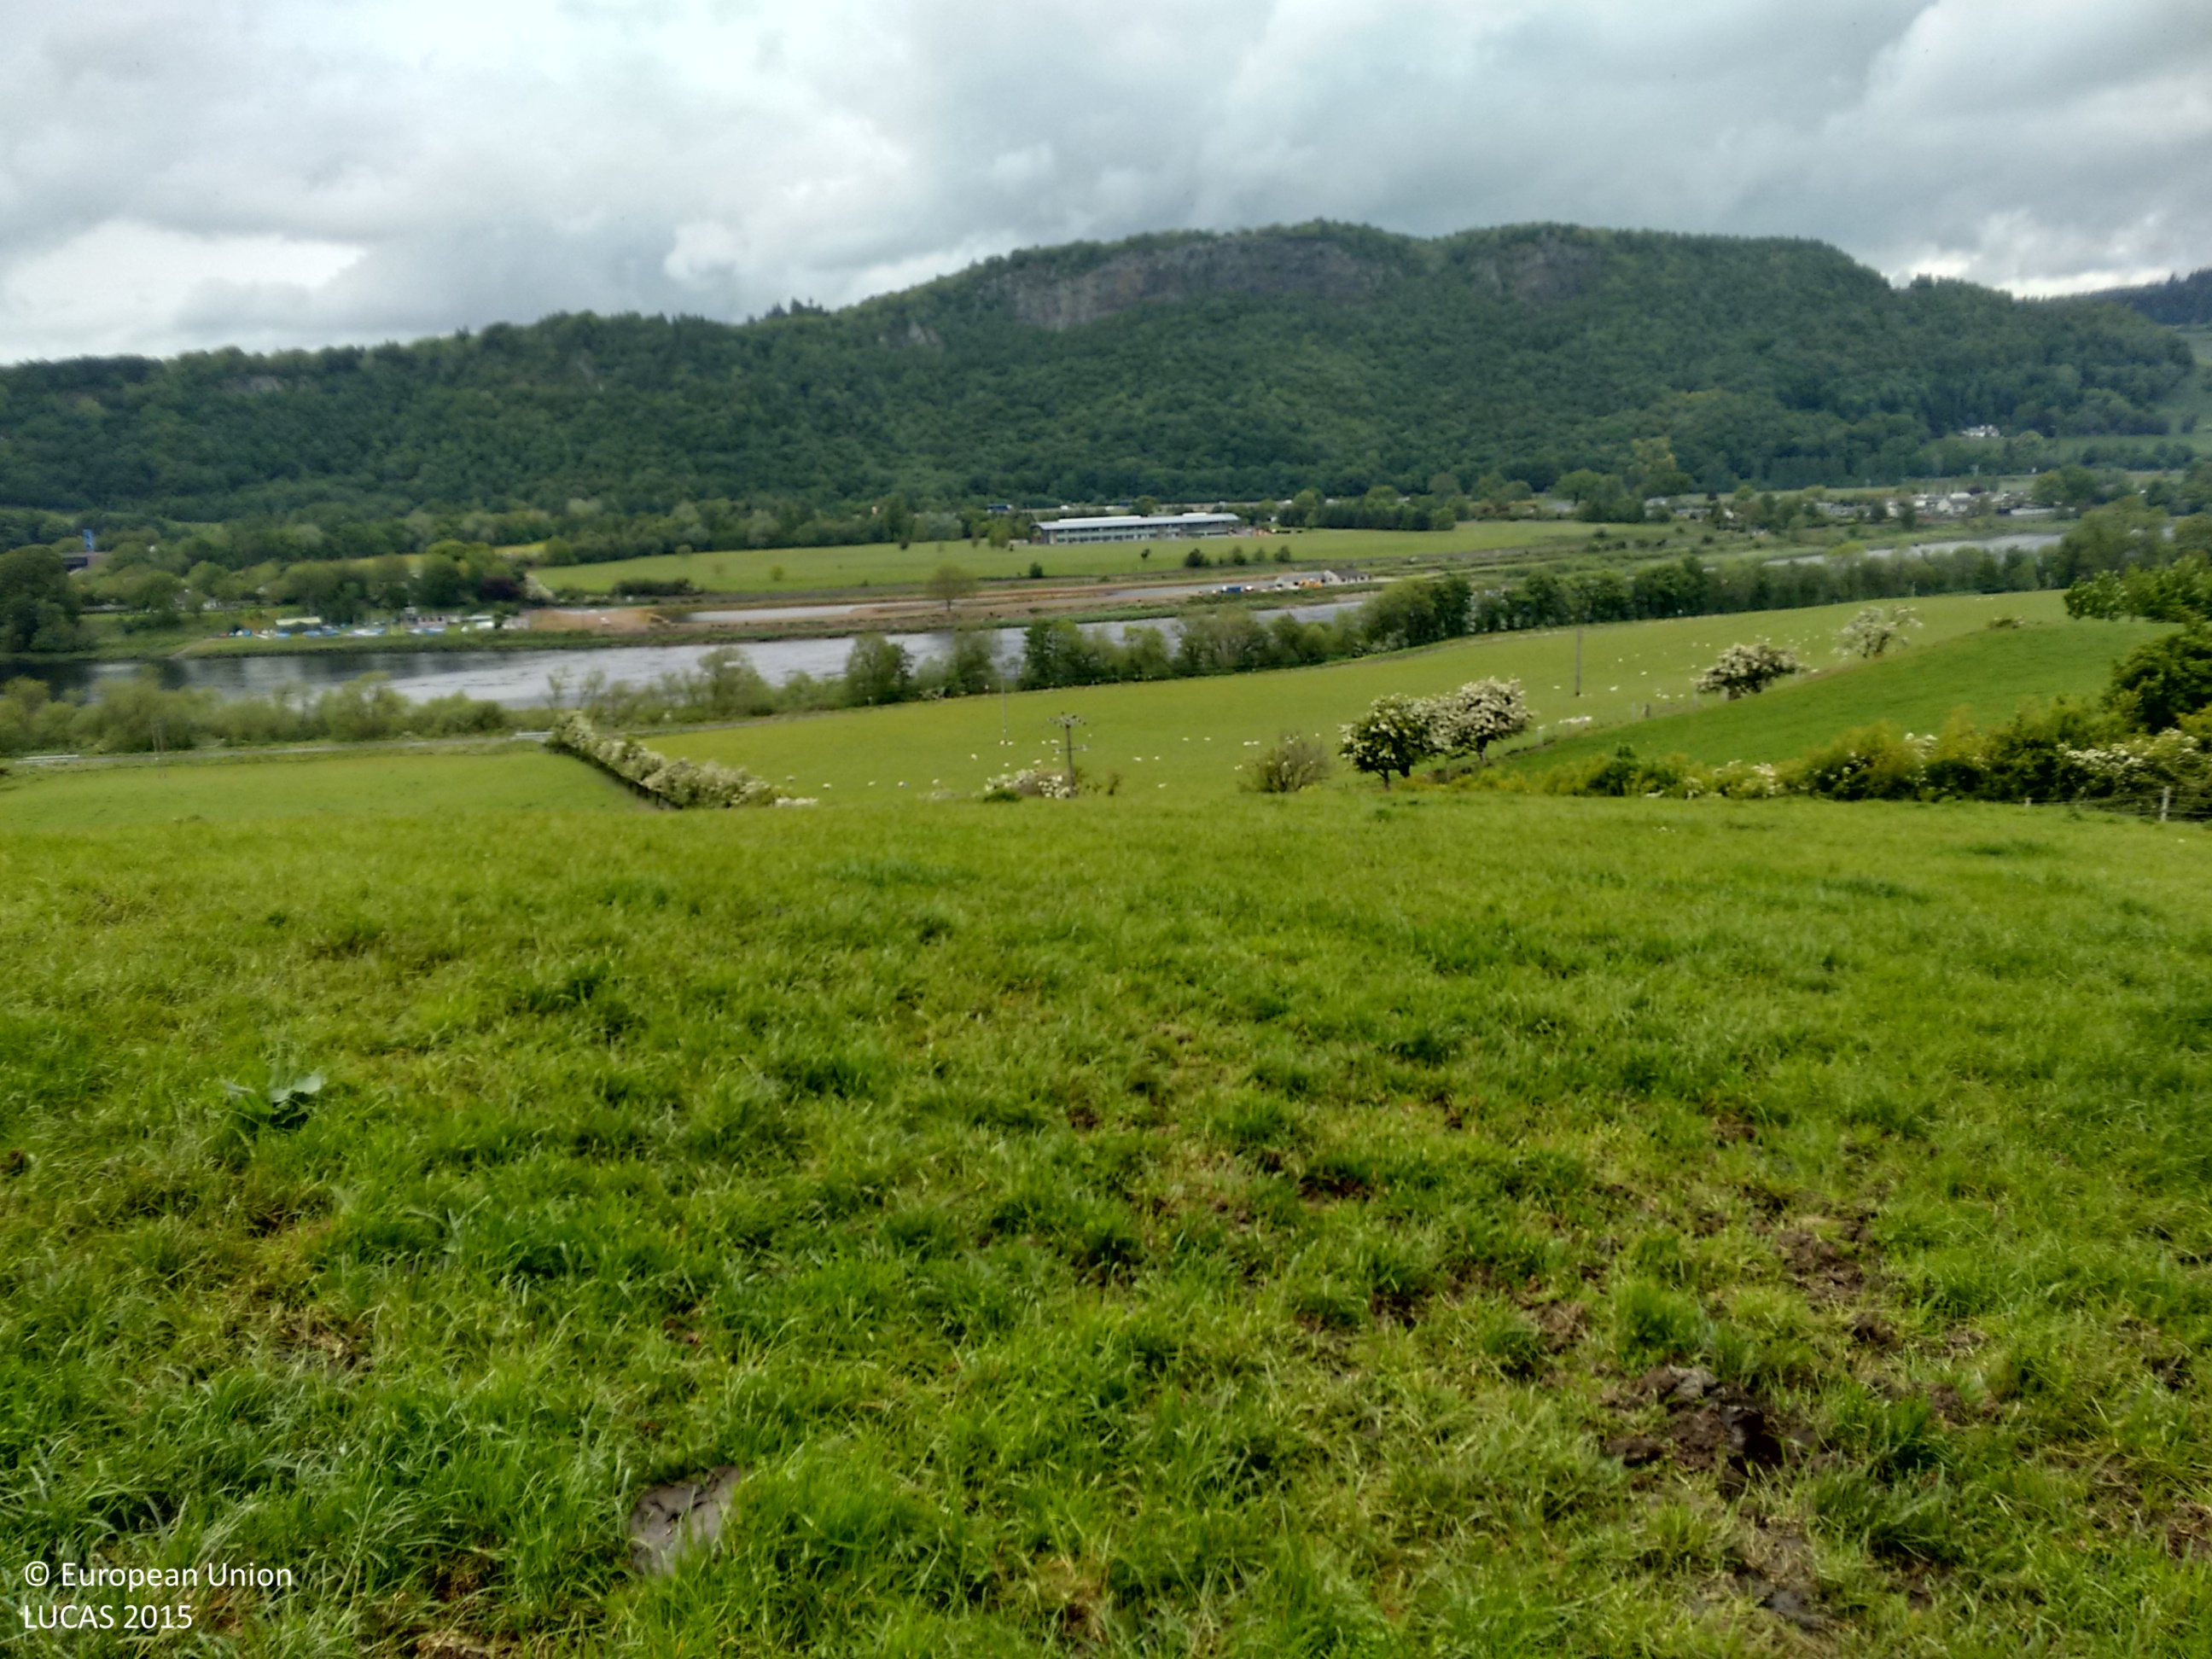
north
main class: Grassland
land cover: Grassland without tree/shrub cover
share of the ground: > 75 %
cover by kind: herbaceous plants 90 %, unconsolidated bare surface 10 %
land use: Agriculture (excluding fallow land and kitchen gardens)
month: June
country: GB
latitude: 56.3753
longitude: -3.3999
